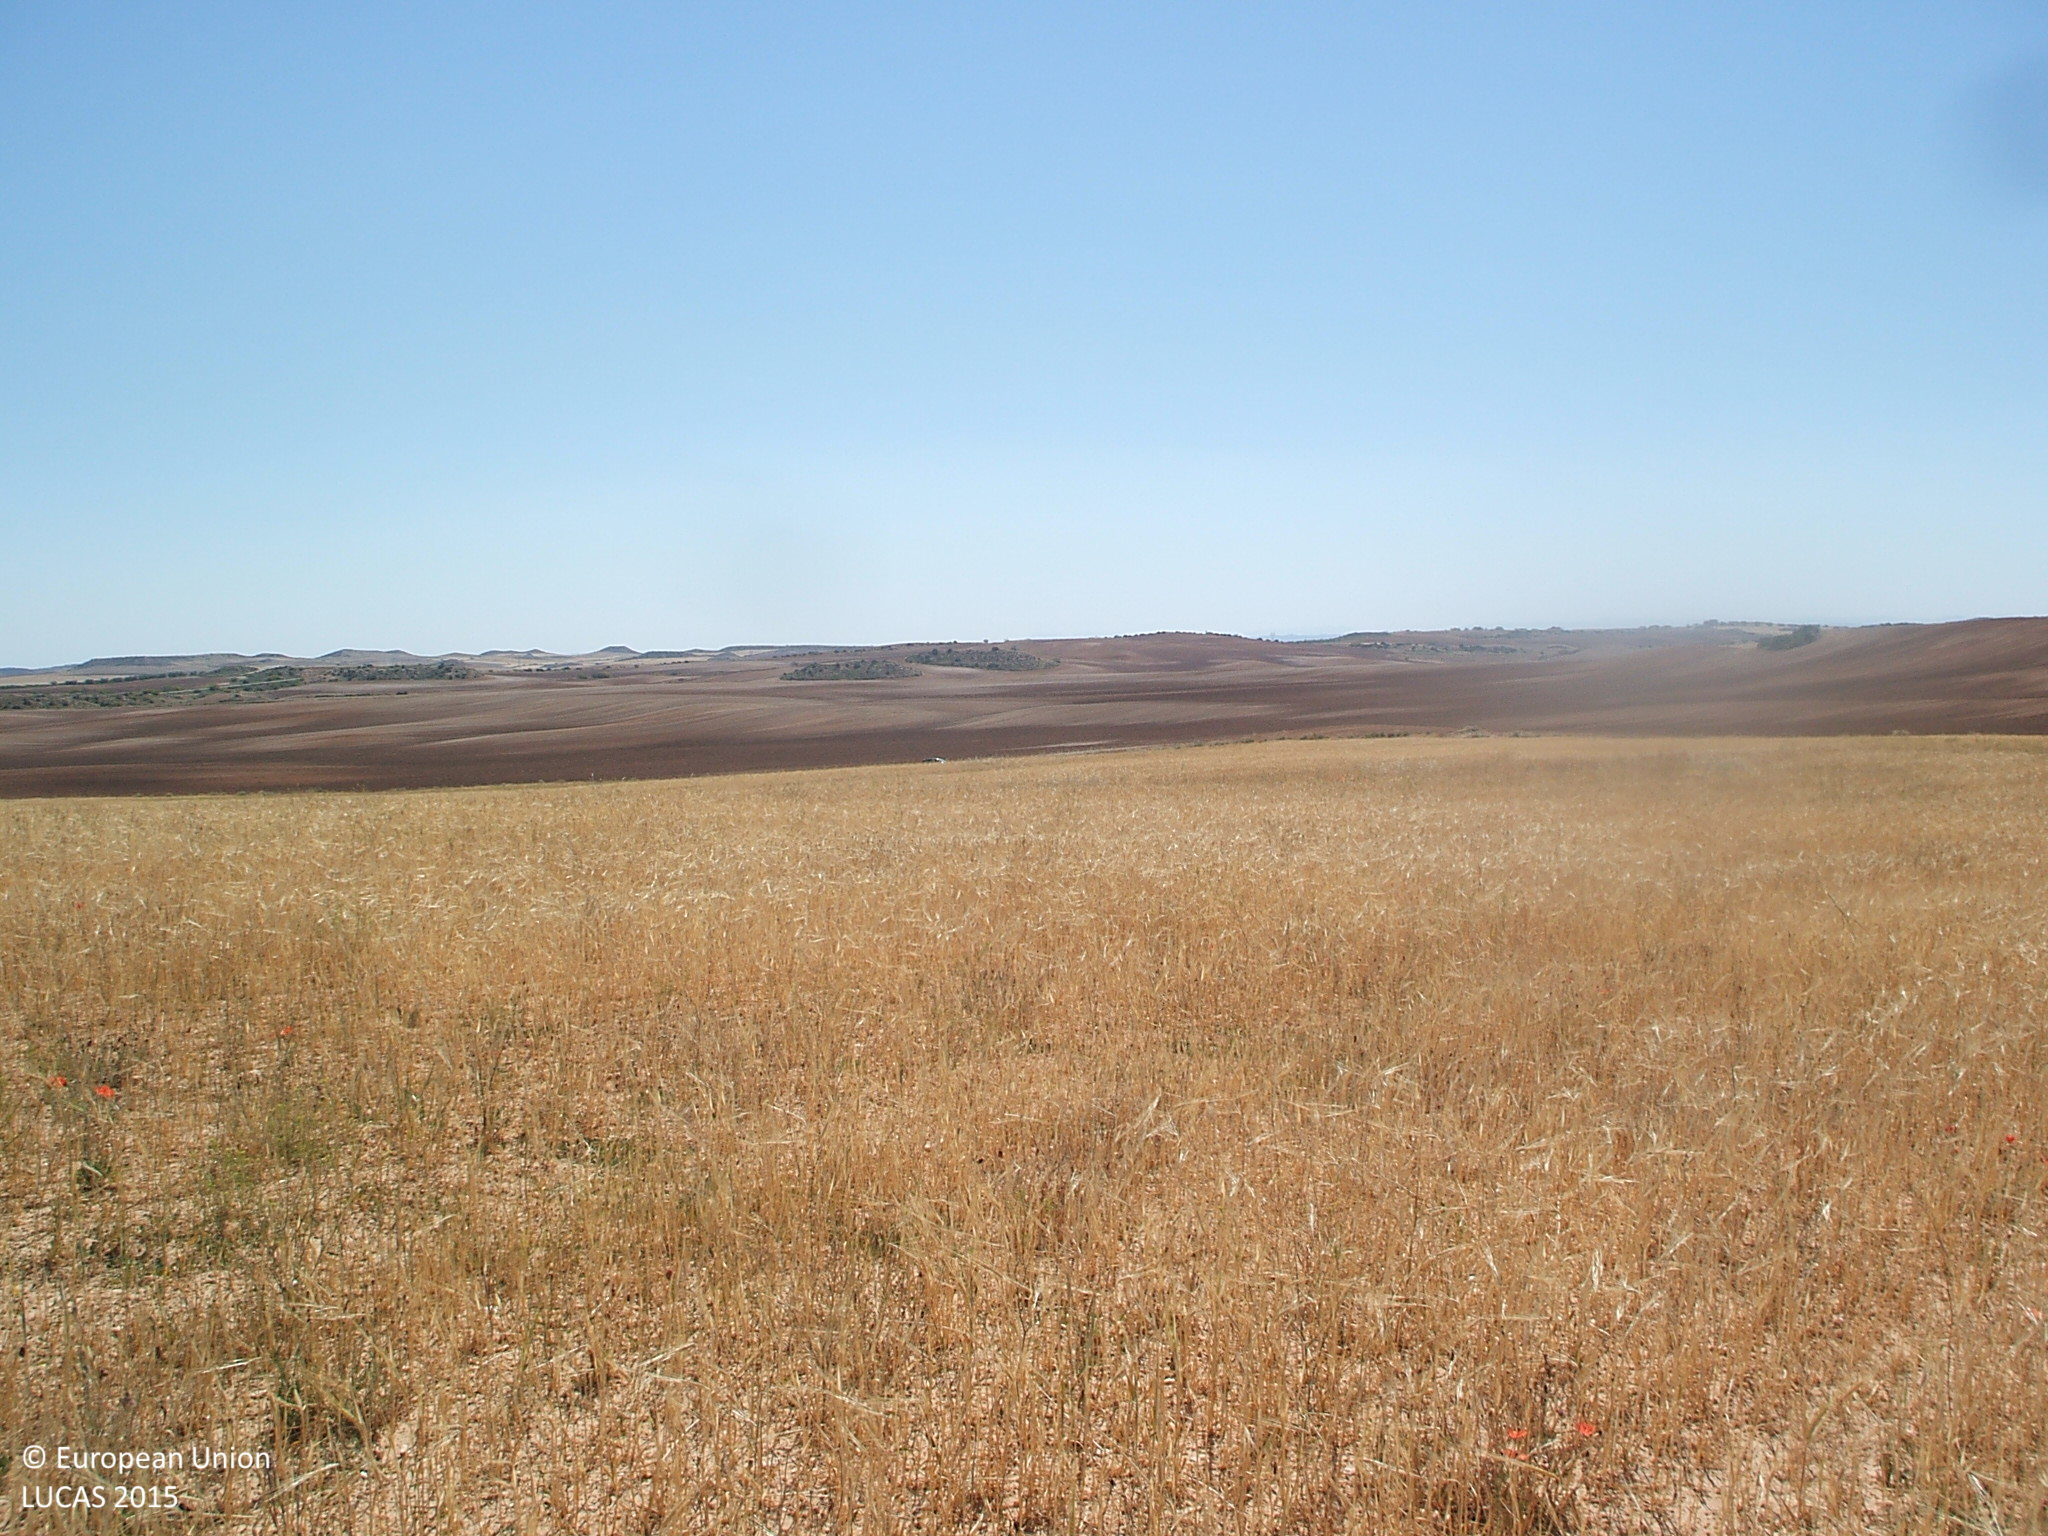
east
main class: Cropland
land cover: Barley
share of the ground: > 75 %
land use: Agriculture (excluding fallow land and kitchen gardens)
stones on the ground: > 50 %
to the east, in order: Barley; Grass margins; Tracks; Grass margins; Other bare soil
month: June
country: ES
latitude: 41.0508
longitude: -0.3278
